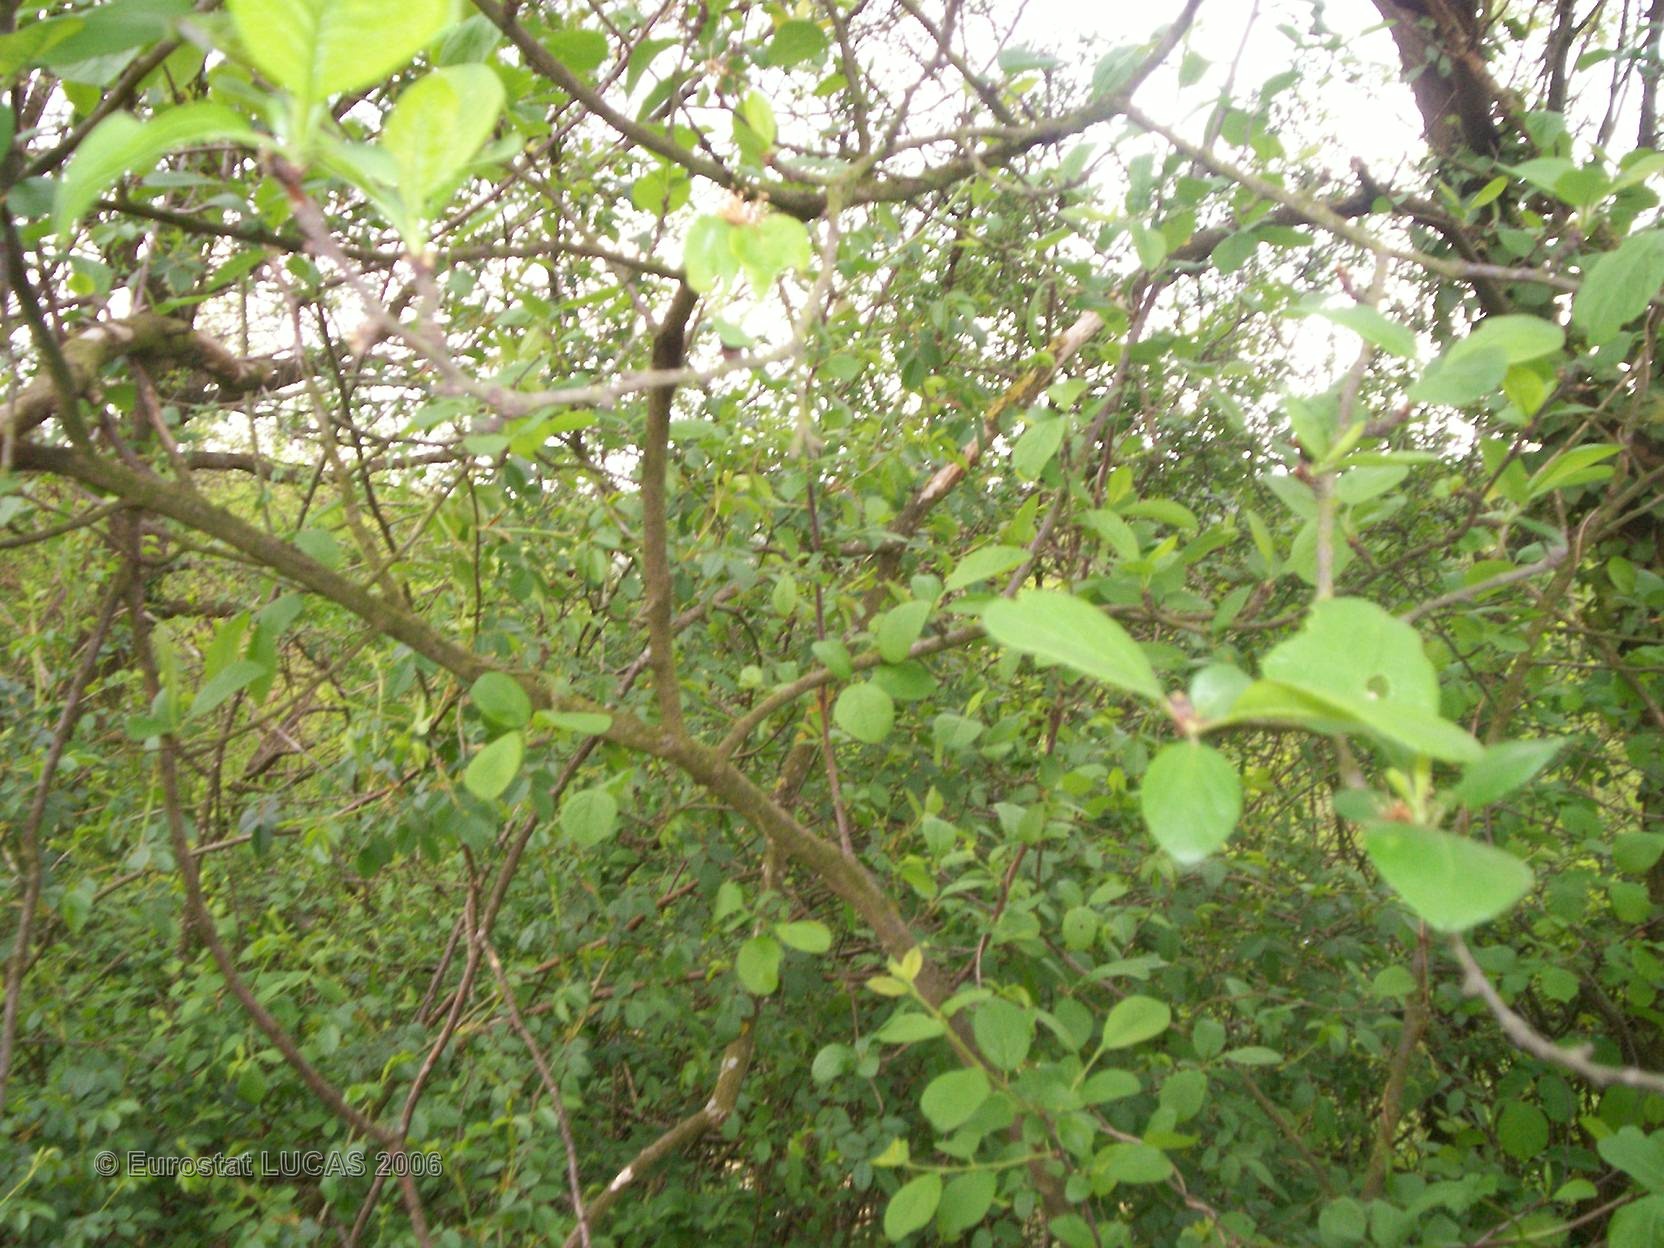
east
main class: Cropland
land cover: Maize
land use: Agriculture (excluding fallow land and kitchen gardens)
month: June
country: FR
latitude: 45.3599
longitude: 4.8343
